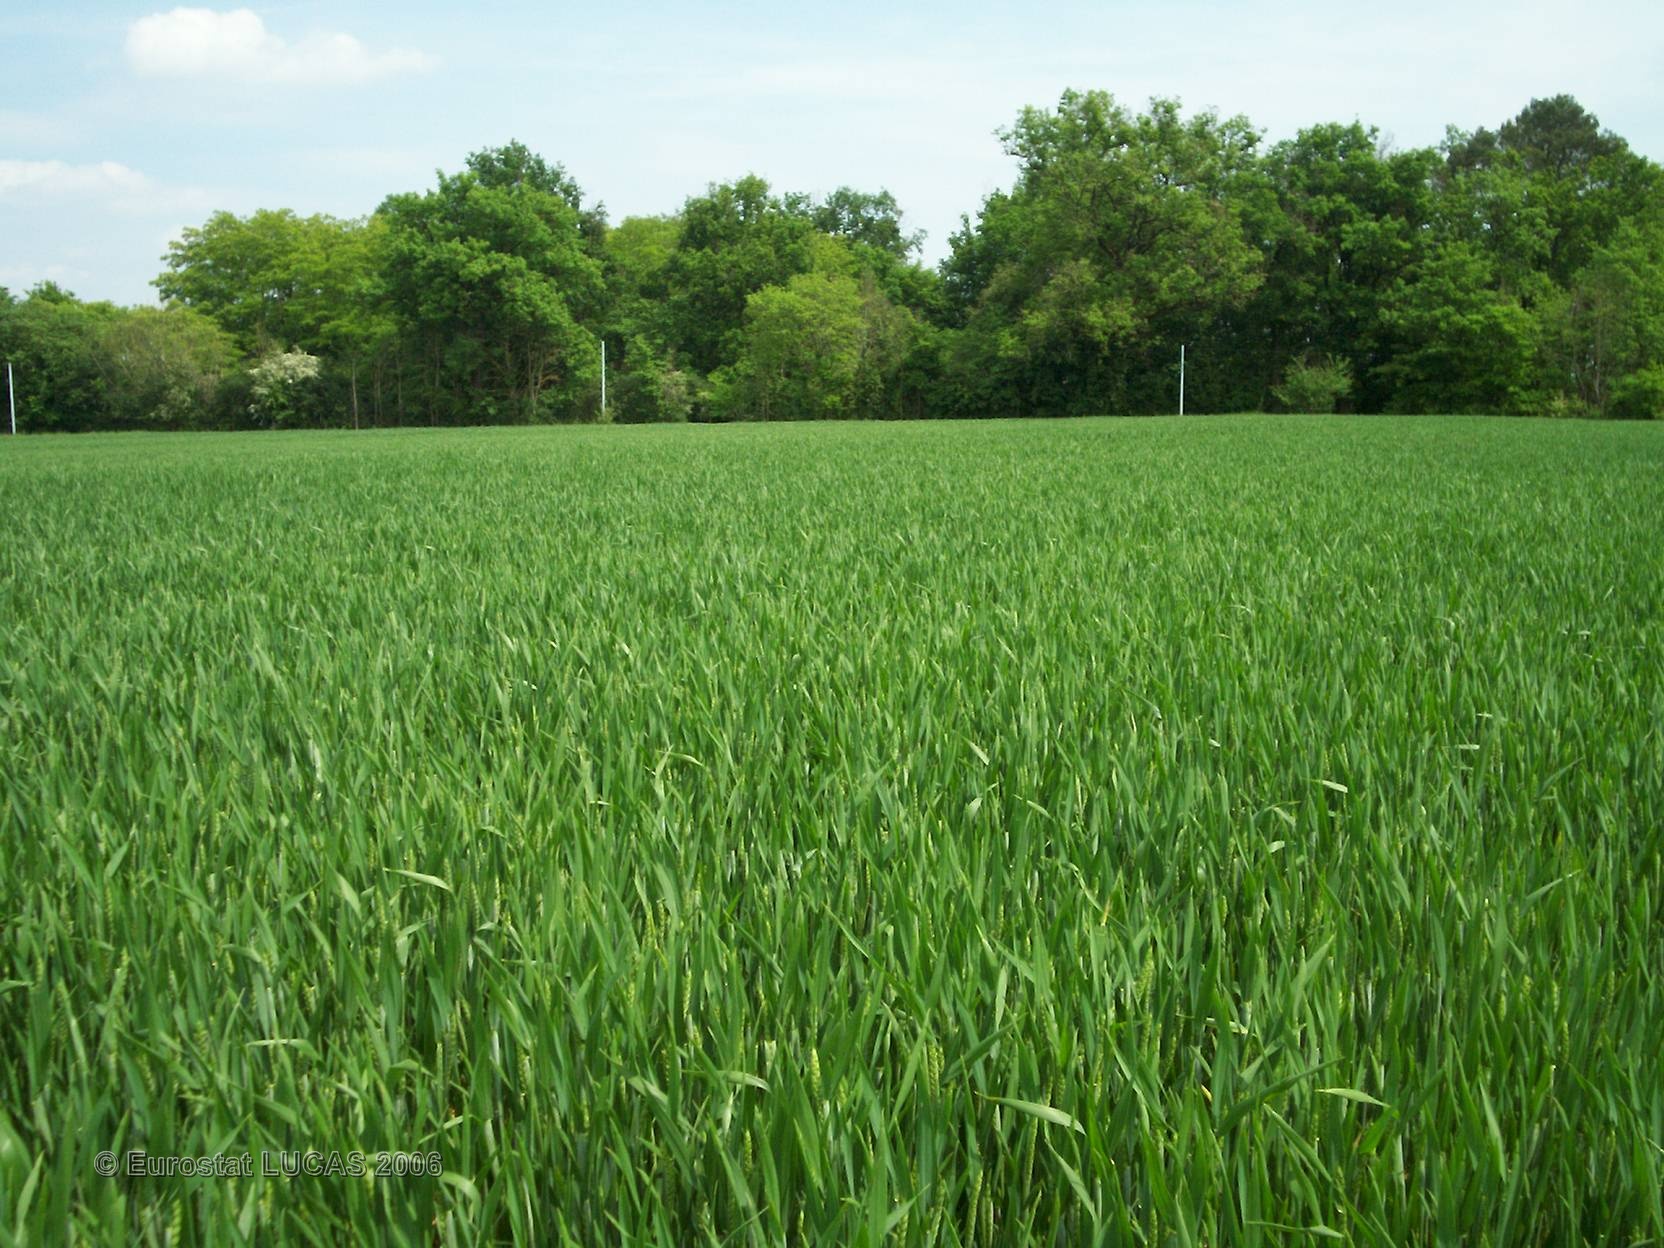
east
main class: Cropland
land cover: Common wheat
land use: Agriculture (excluding fallow land and kitchen gardens)
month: May
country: FR
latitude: 46.8053
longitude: 1.0092
